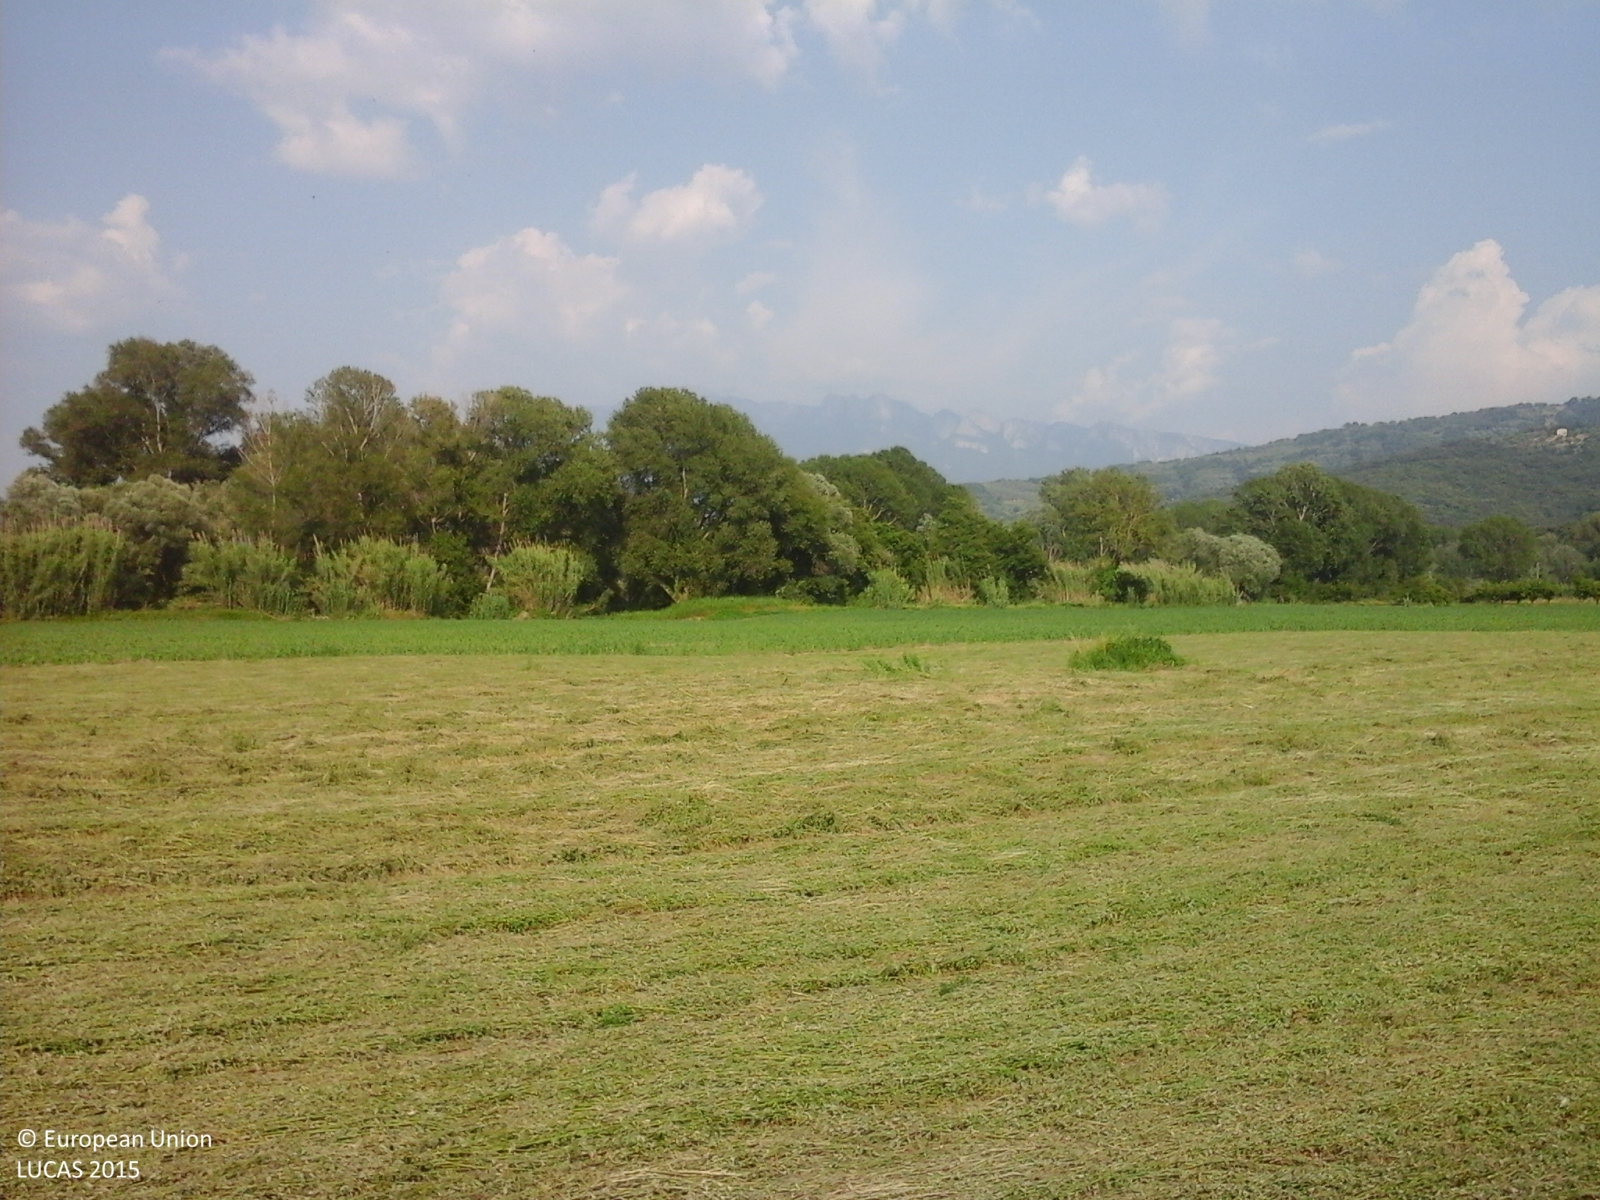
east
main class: Cropland
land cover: Other leguminous and mixtures for fodder
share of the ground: > 75 %
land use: Agriculture (excluding fallow land and kitchen gardens)
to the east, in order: Other leguminous and mixtures for fodder; Maize; Tracks; Maize; Tracks; Spontaneously vegetated surfaces; Broadleaved woodland; Inland fresh running water; Broadleaved woodland; Spontaneously vegetated surfaces; Maize
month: June
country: IT
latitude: 40.5508
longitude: 15.1154
